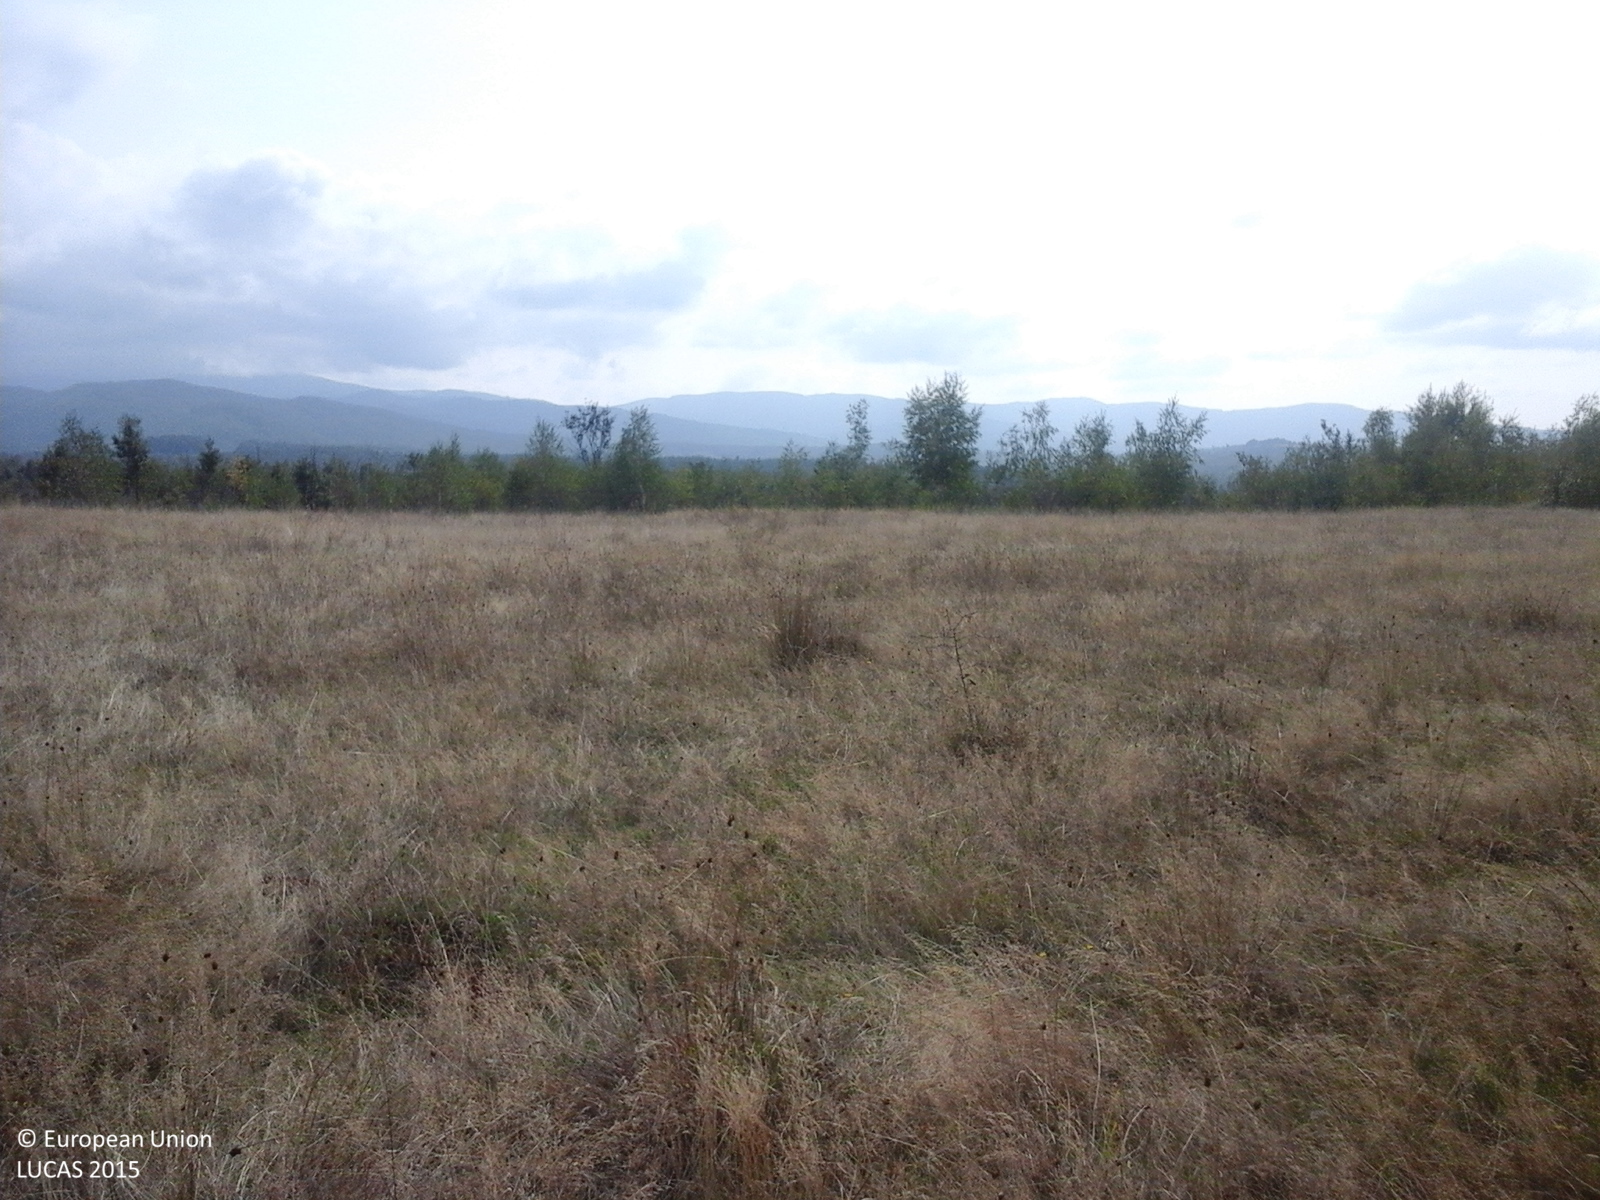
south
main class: Grassland
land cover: Grassland with sparse tree/shrub cover
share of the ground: > 75 %
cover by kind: herbaceous plants 85 %, shrubs 10 %, broadleaved forest trees 5 %
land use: Agriculture (excluding fallow land and kitchen gardens)
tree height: < 5 m
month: September
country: RO
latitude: 45.8044
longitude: 22.2809
